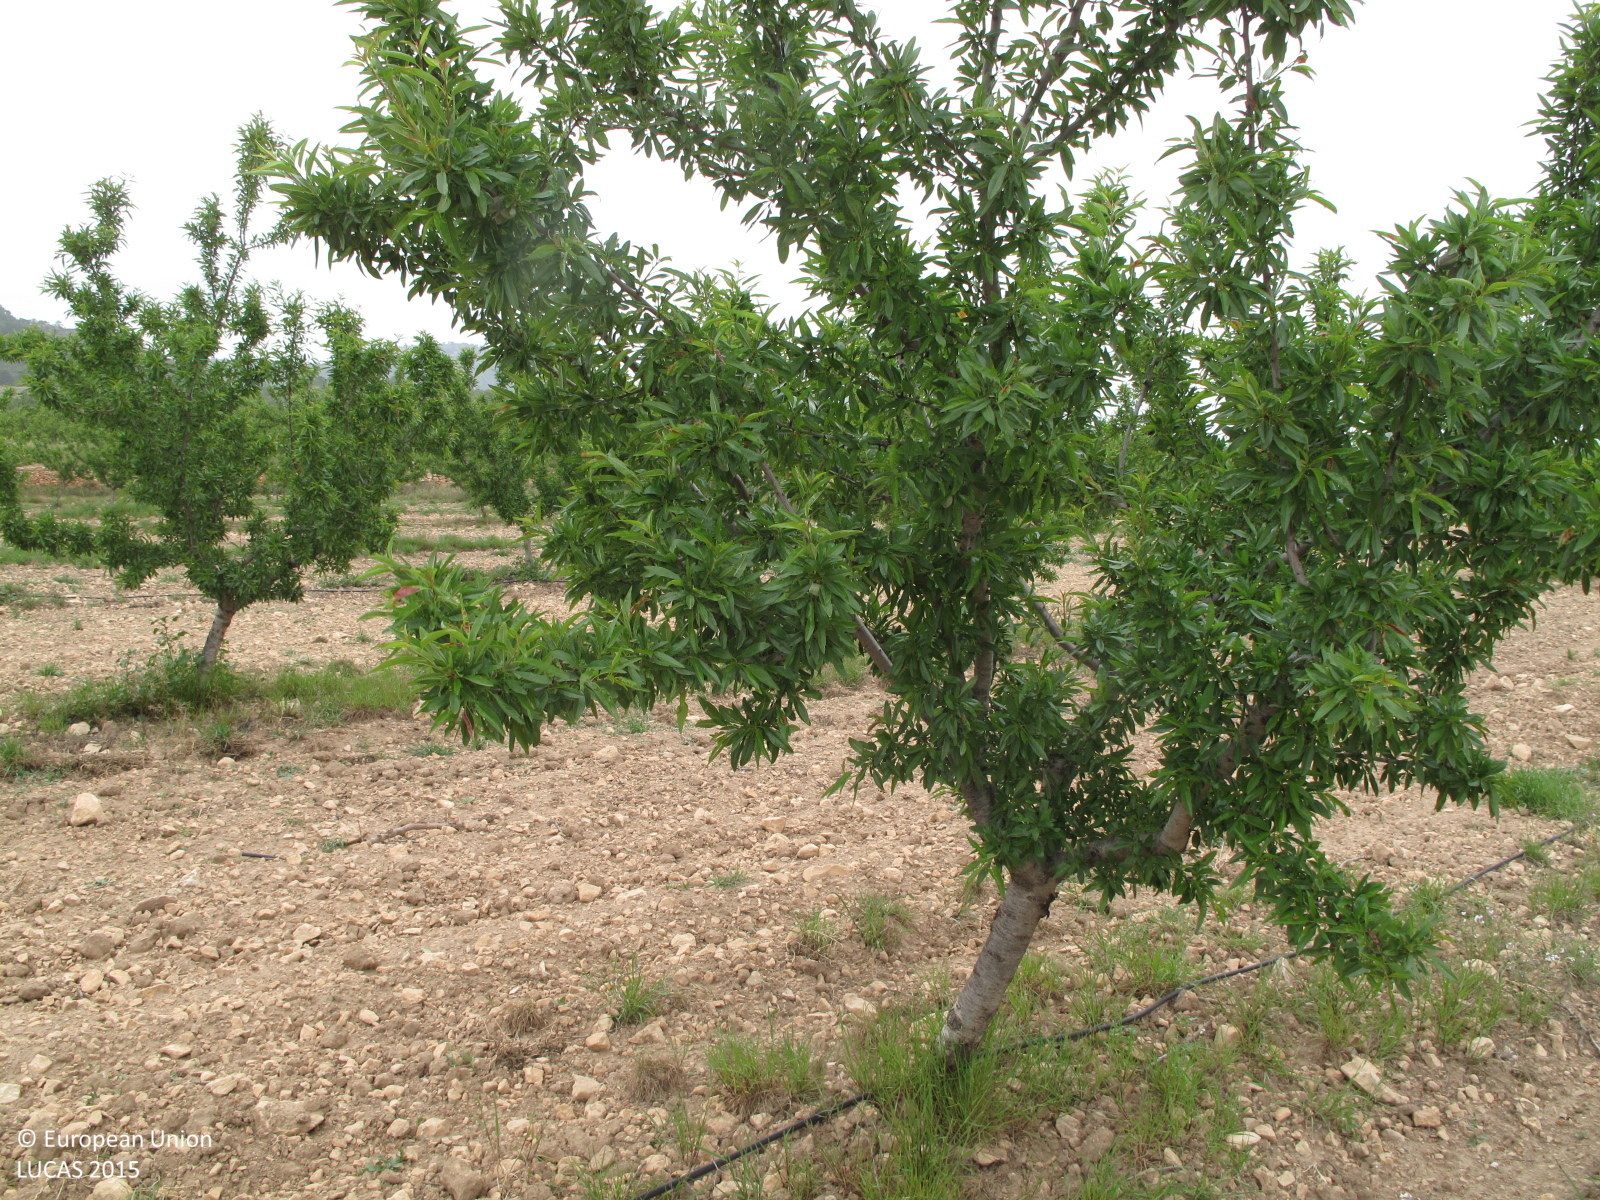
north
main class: Cropland
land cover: Nuts trees
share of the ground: 10 - 25 %
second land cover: Spontaneously vegetated surfaces
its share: 10 - 25 %
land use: Agriculture (excluding fallow land and kitchen gardens)
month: April
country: ES
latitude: 38.4497
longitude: -0.9312
